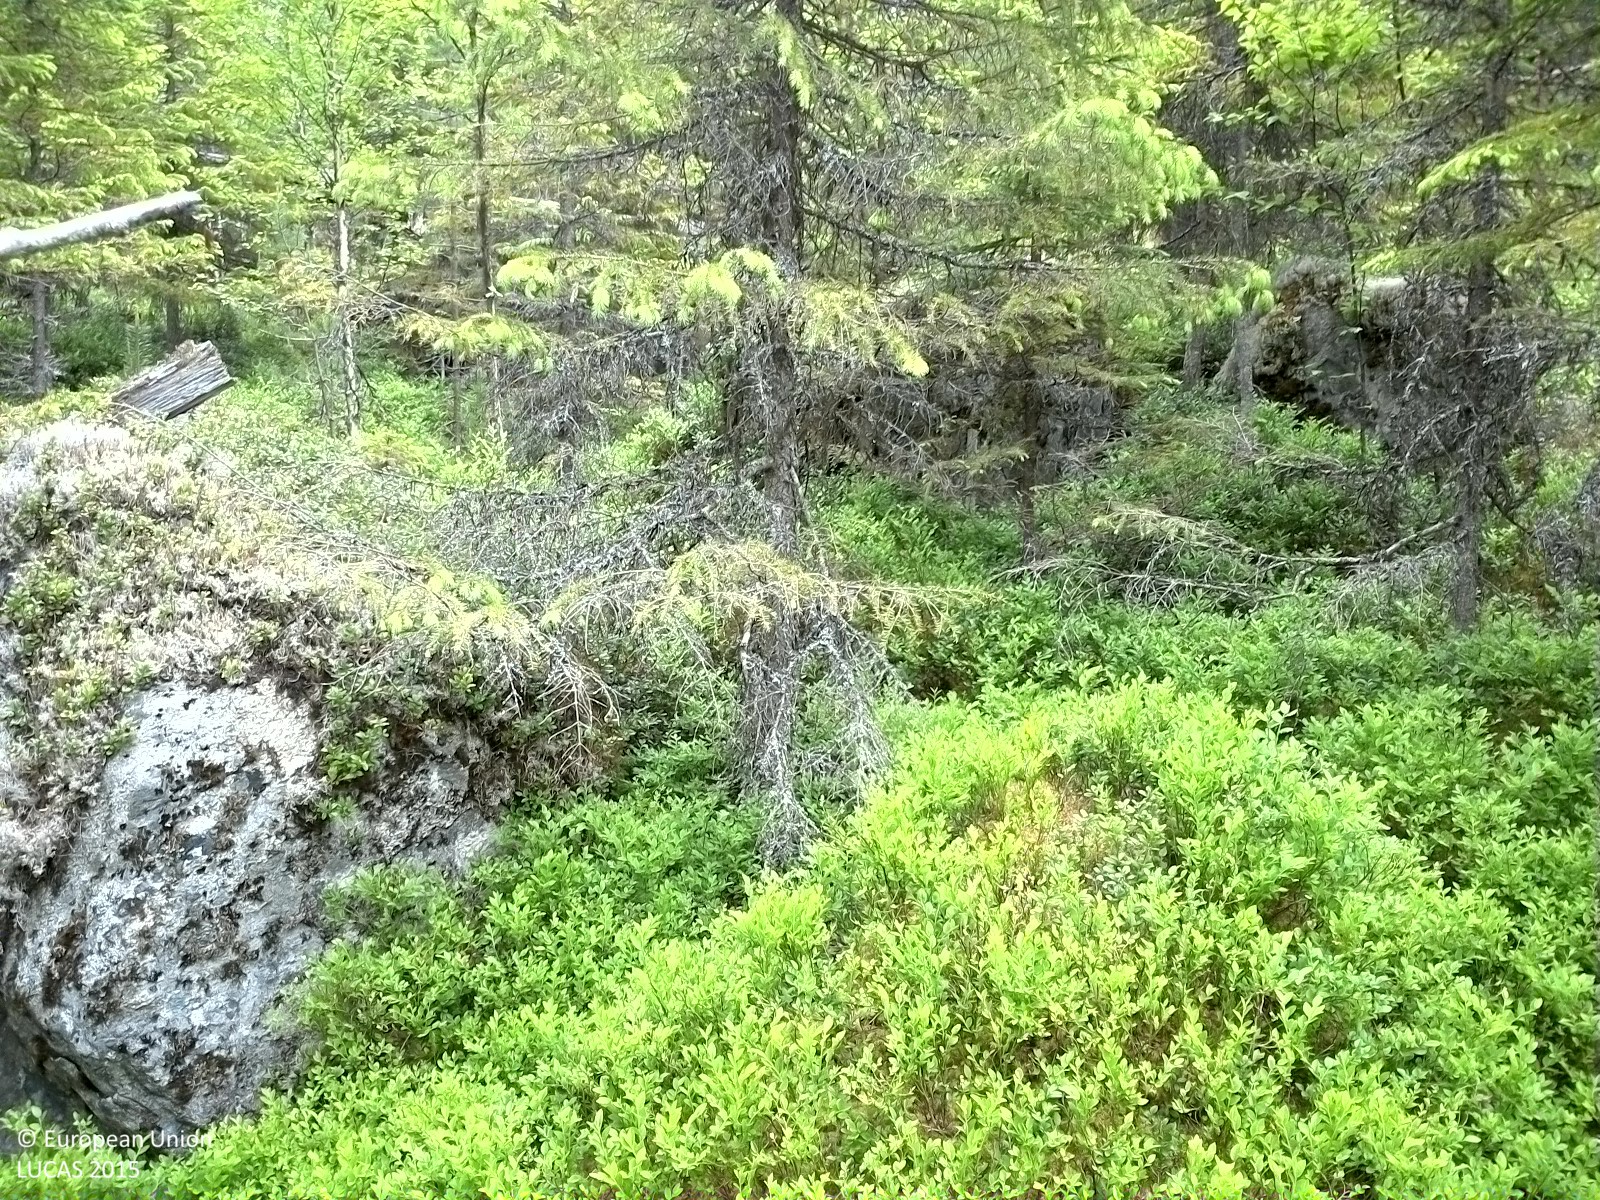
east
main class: Woodland
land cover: Spruce dominated coniferous woodland
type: boreal forest
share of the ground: 25 - 50 %
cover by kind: coniferous forest trees 45 %, shrubs 45 %, broadleaved forest trees 5 %, herbaceous plants 5 %
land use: Forestry
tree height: > 5 m
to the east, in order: Spruce dominated coniferous woodland; Pine dominated coniferous woodland; Pine dominated mixed woodland
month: June
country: SE
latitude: 62.1224
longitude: 16.2115
